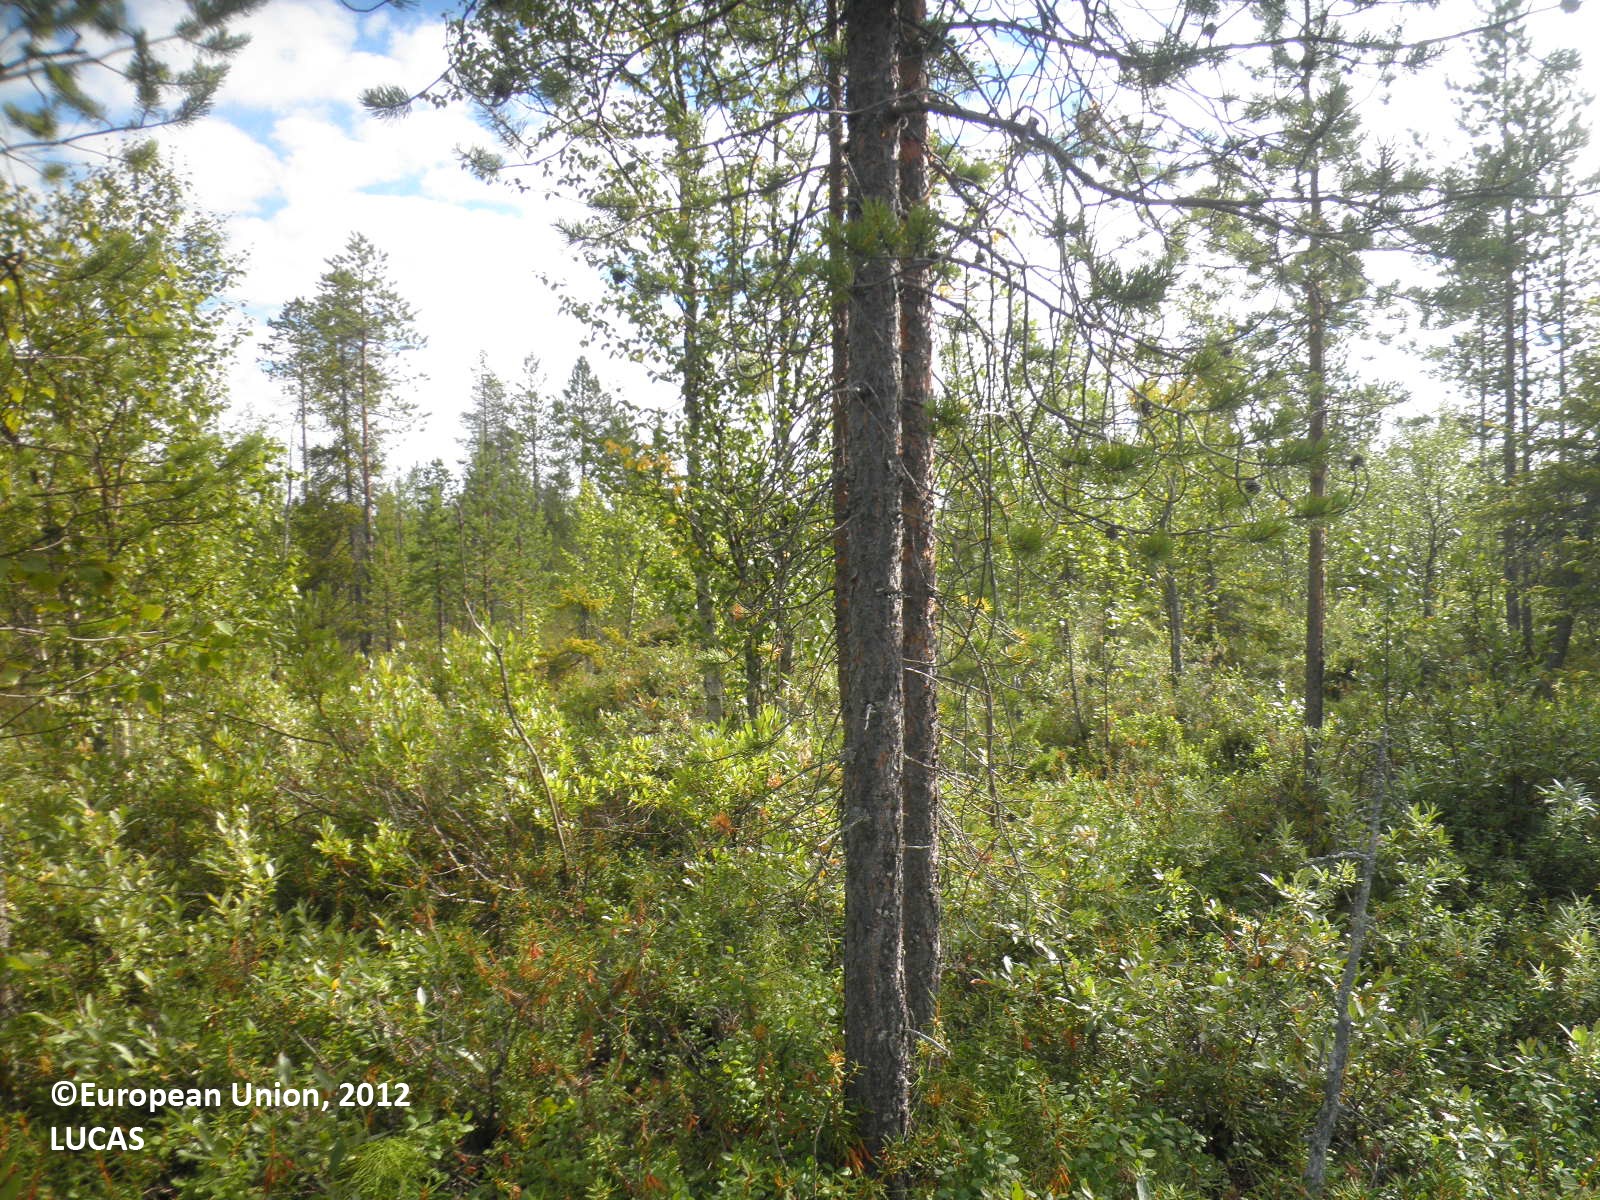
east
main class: Woodland
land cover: Pine dominated mixed woodland
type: boreal forest
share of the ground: 25 - 50 %
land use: Forestry
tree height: > 5 m
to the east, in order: Pine dominated mixed woodland; Pine dominated coniferous woodland; Rivers and streams; Pine dominated coniferous woodland; Pine dominated mixed woodland; Pine dominated coniferous woodland
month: August
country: FI
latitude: 67.5038
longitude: 27.0653
